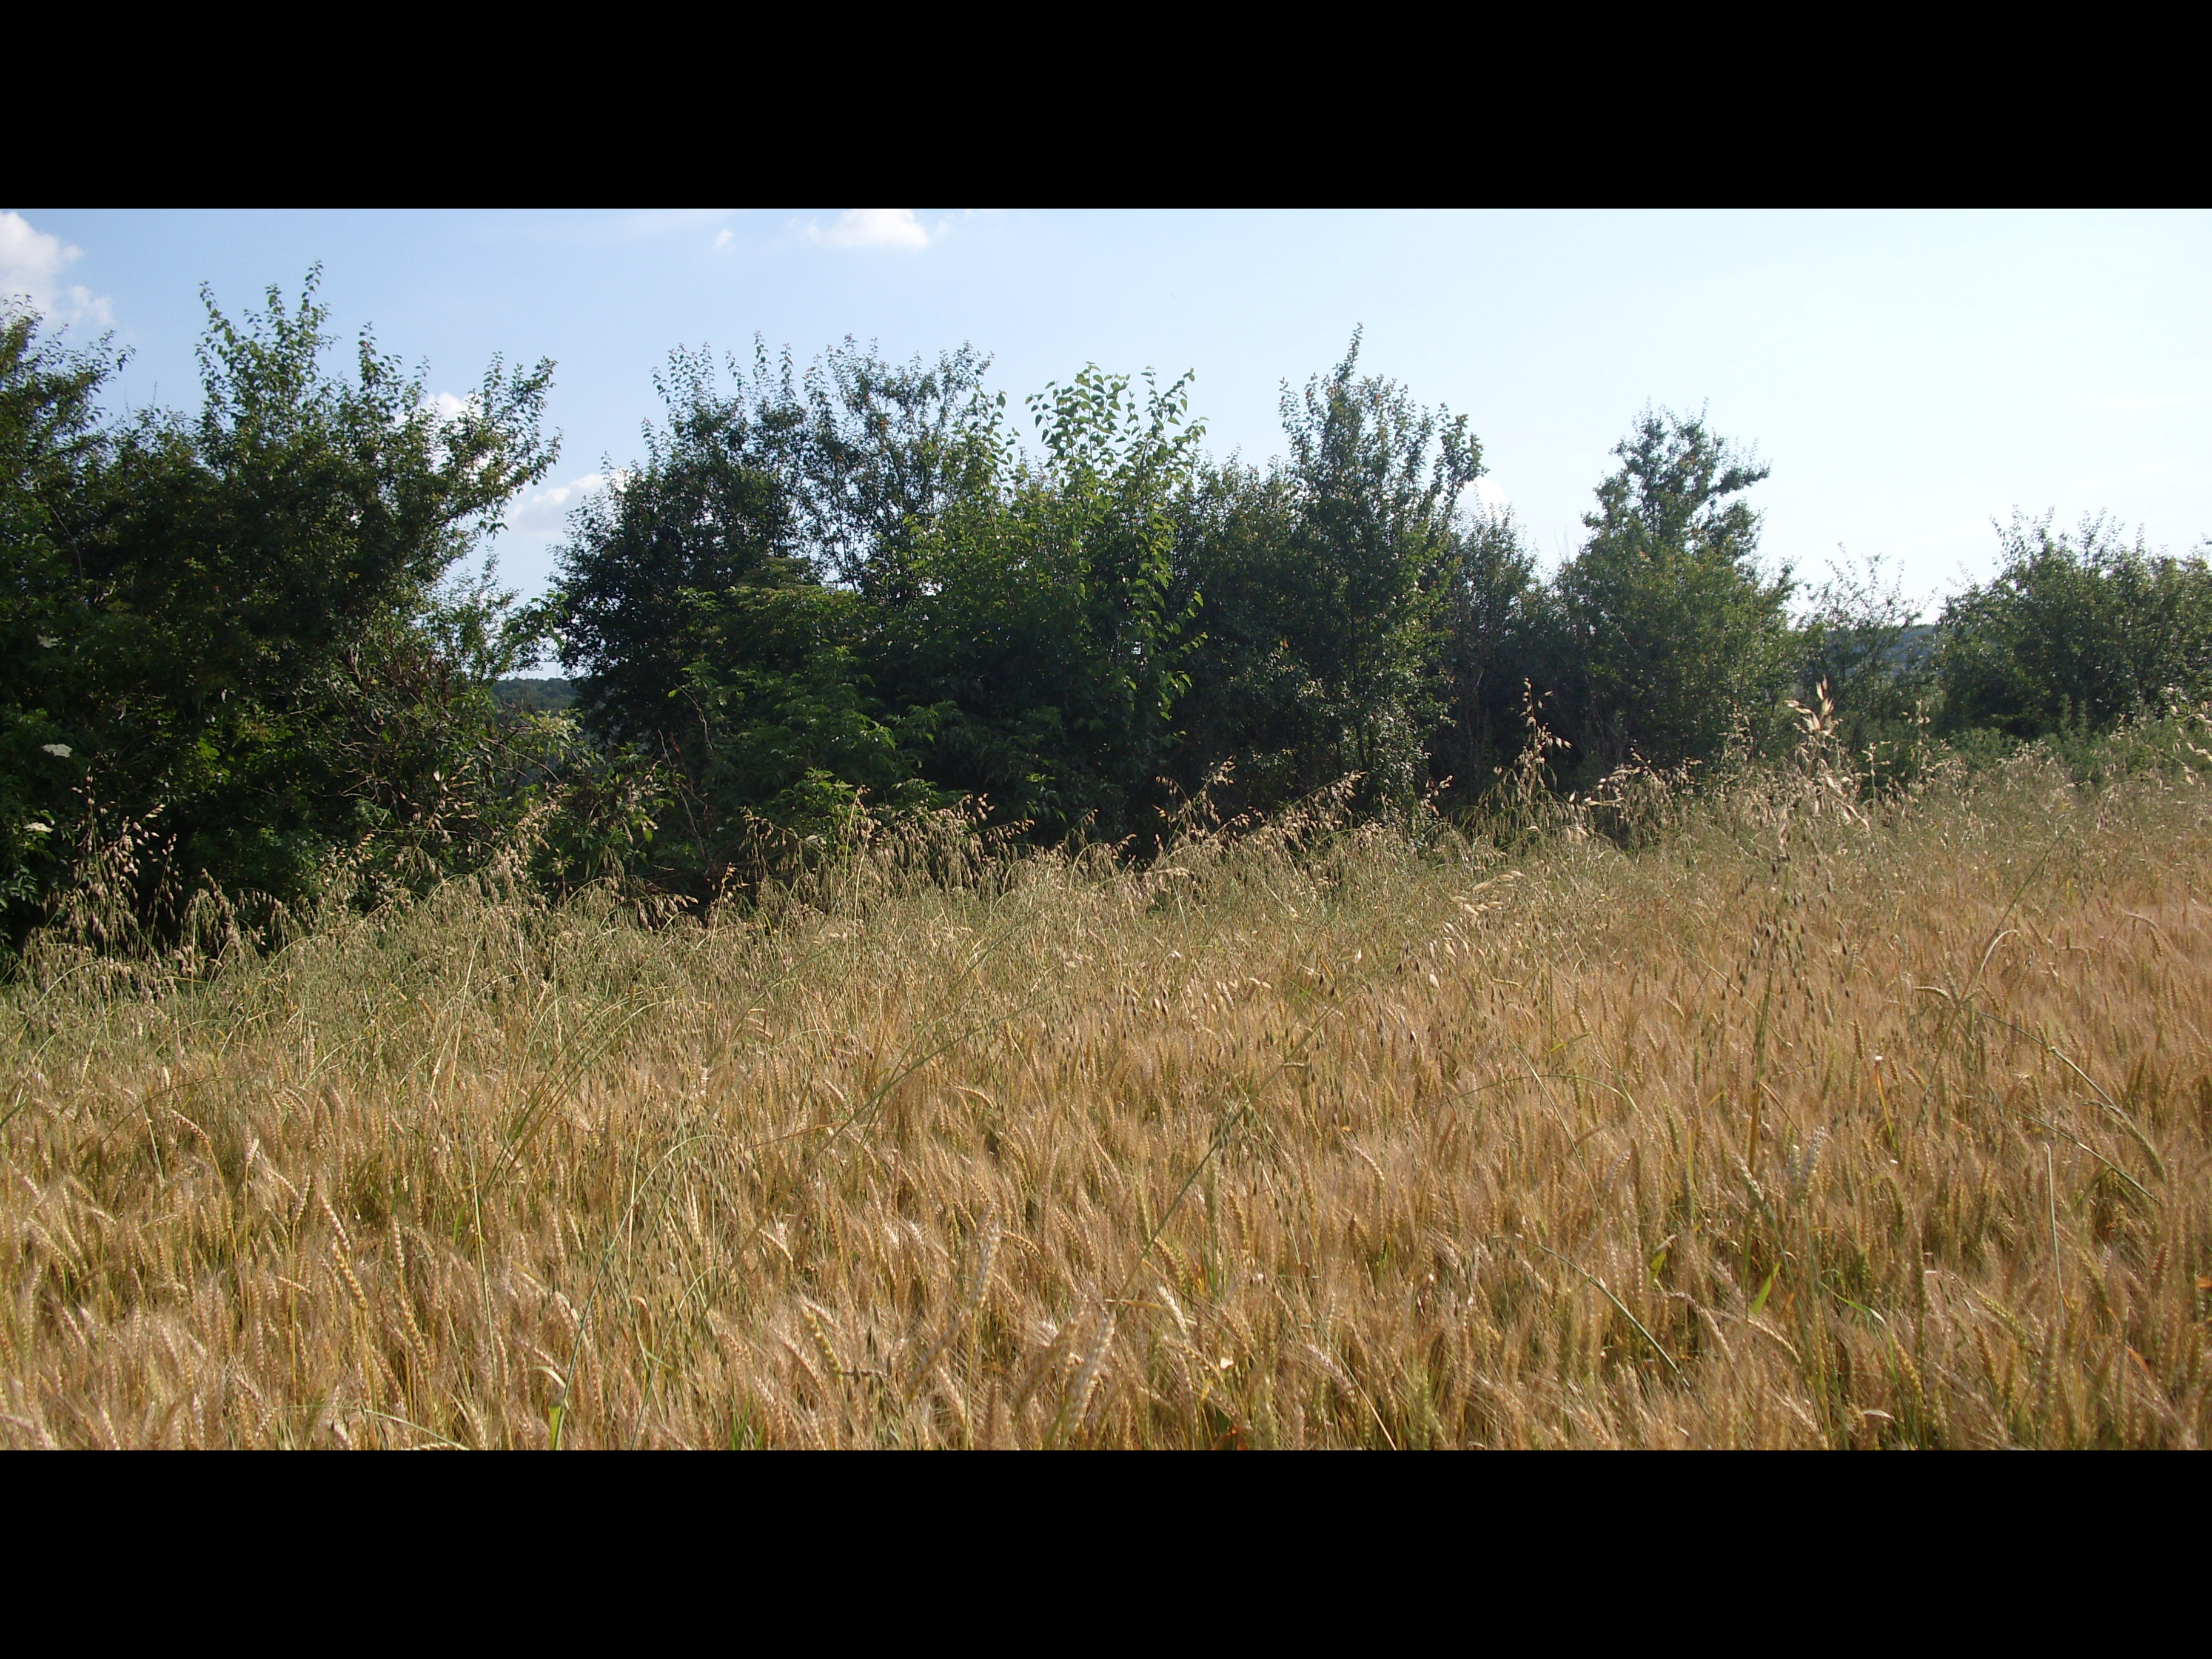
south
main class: Cropland
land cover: Common wheat
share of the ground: > 75 %
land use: Agriculture (excluding fallow land and kitchen gardens)
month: June
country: BG
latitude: 43.5292
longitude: 23.4193
